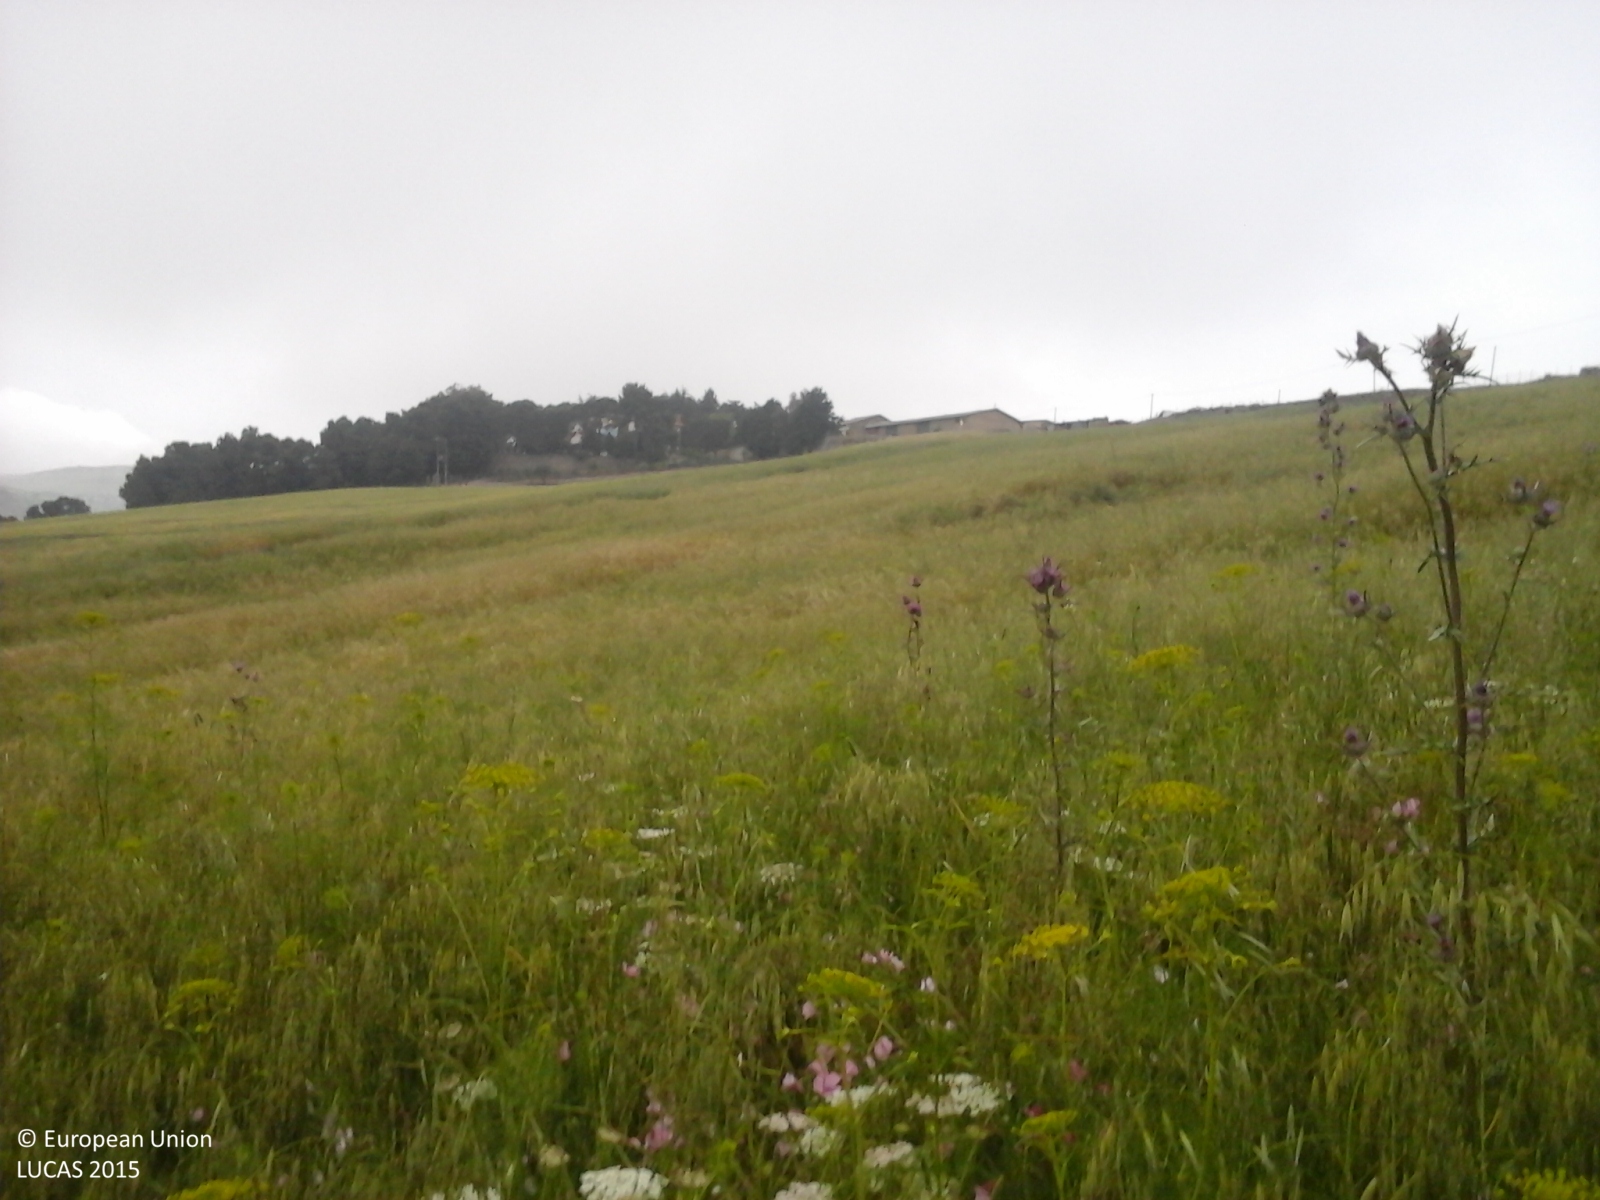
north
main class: Grassland
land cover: Spontaneously vegetated surfaces
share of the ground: > 75 %
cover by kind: herbaceous plants 100 %
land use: Fallow land
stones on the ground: < 10 %
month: May
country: IT
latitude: 37.7561
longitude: 13.9554
